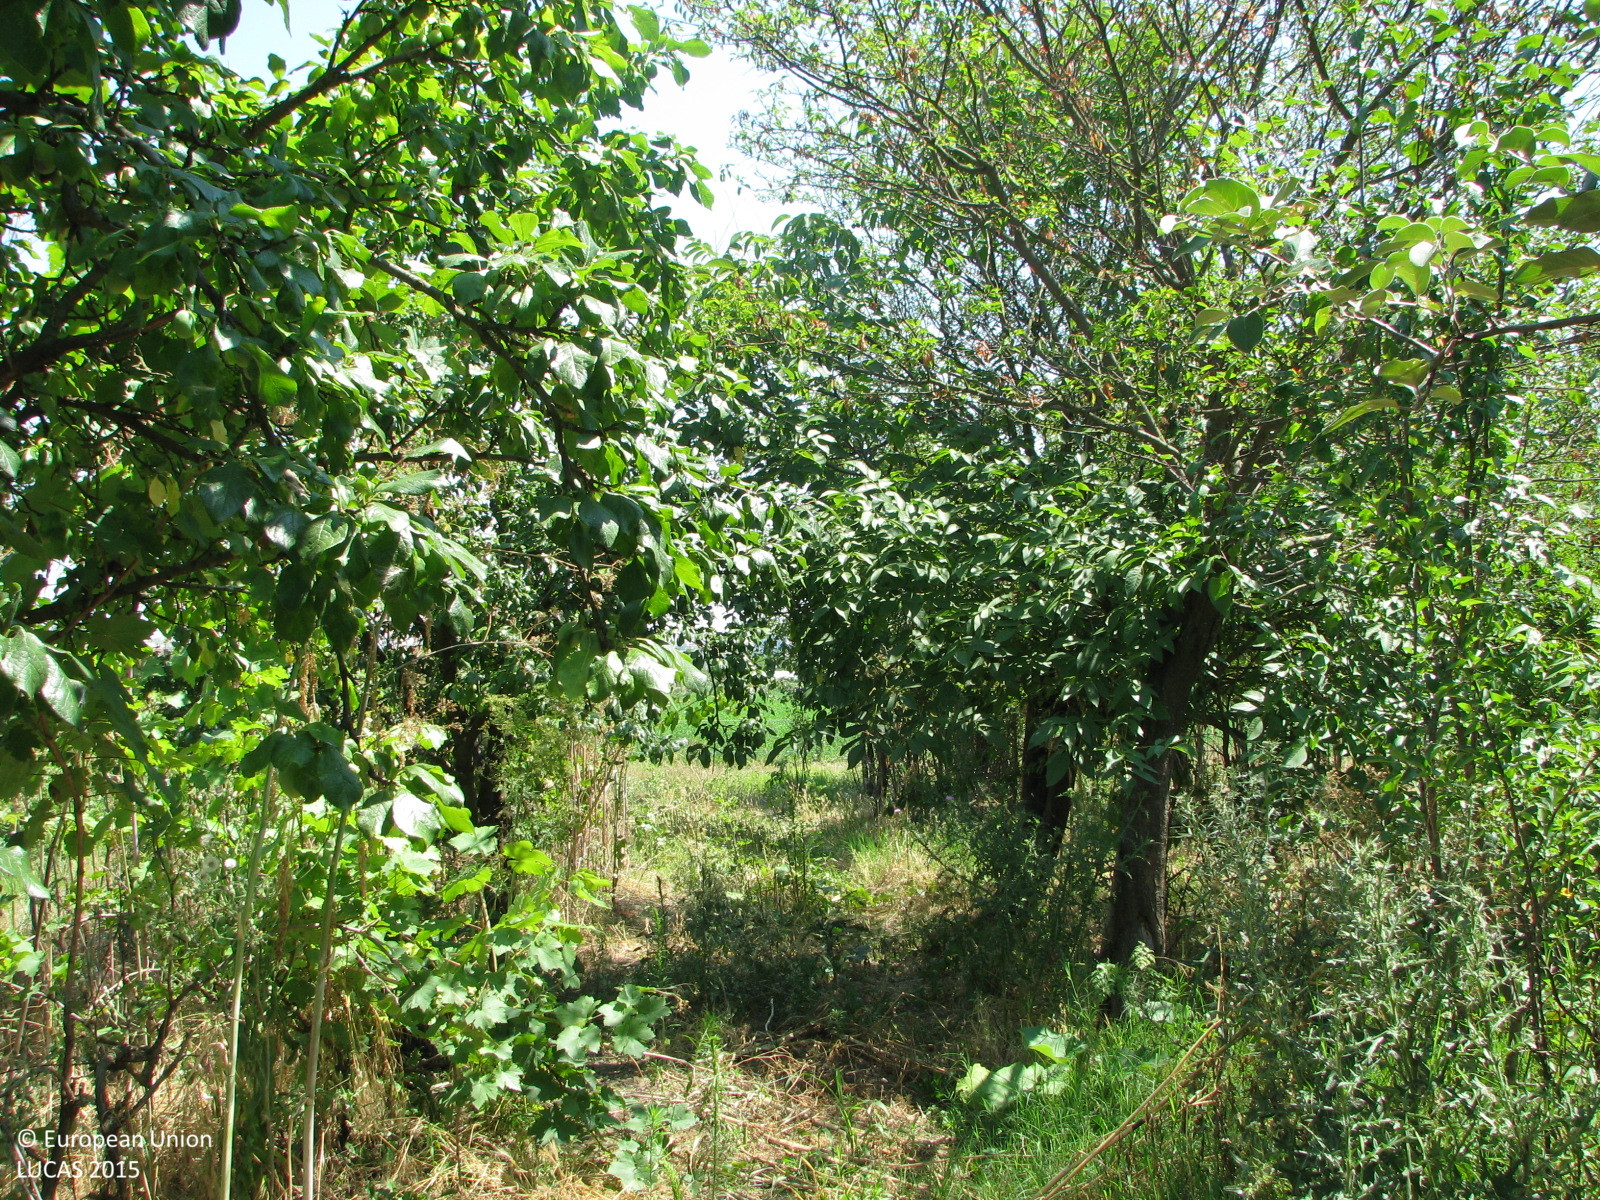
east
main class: Cropland
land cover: Other fruit trees and berries
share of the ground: 50 - 75 %
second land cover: Spontaneously vegetated surfaces
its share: 25 - 50 %
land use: Abandoned areas
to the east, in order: Other fruit trees and berries; Spontaneously vegetated surfaces; Tracks; Grass margins; Fences; Lucerne; Grass margins; Tracks; Grass margins; Ditches and canals; Grass margins; Tracks; Grassland without tree/shrub cover
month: July
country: BG
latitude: 42.4672
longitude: 26.4986
